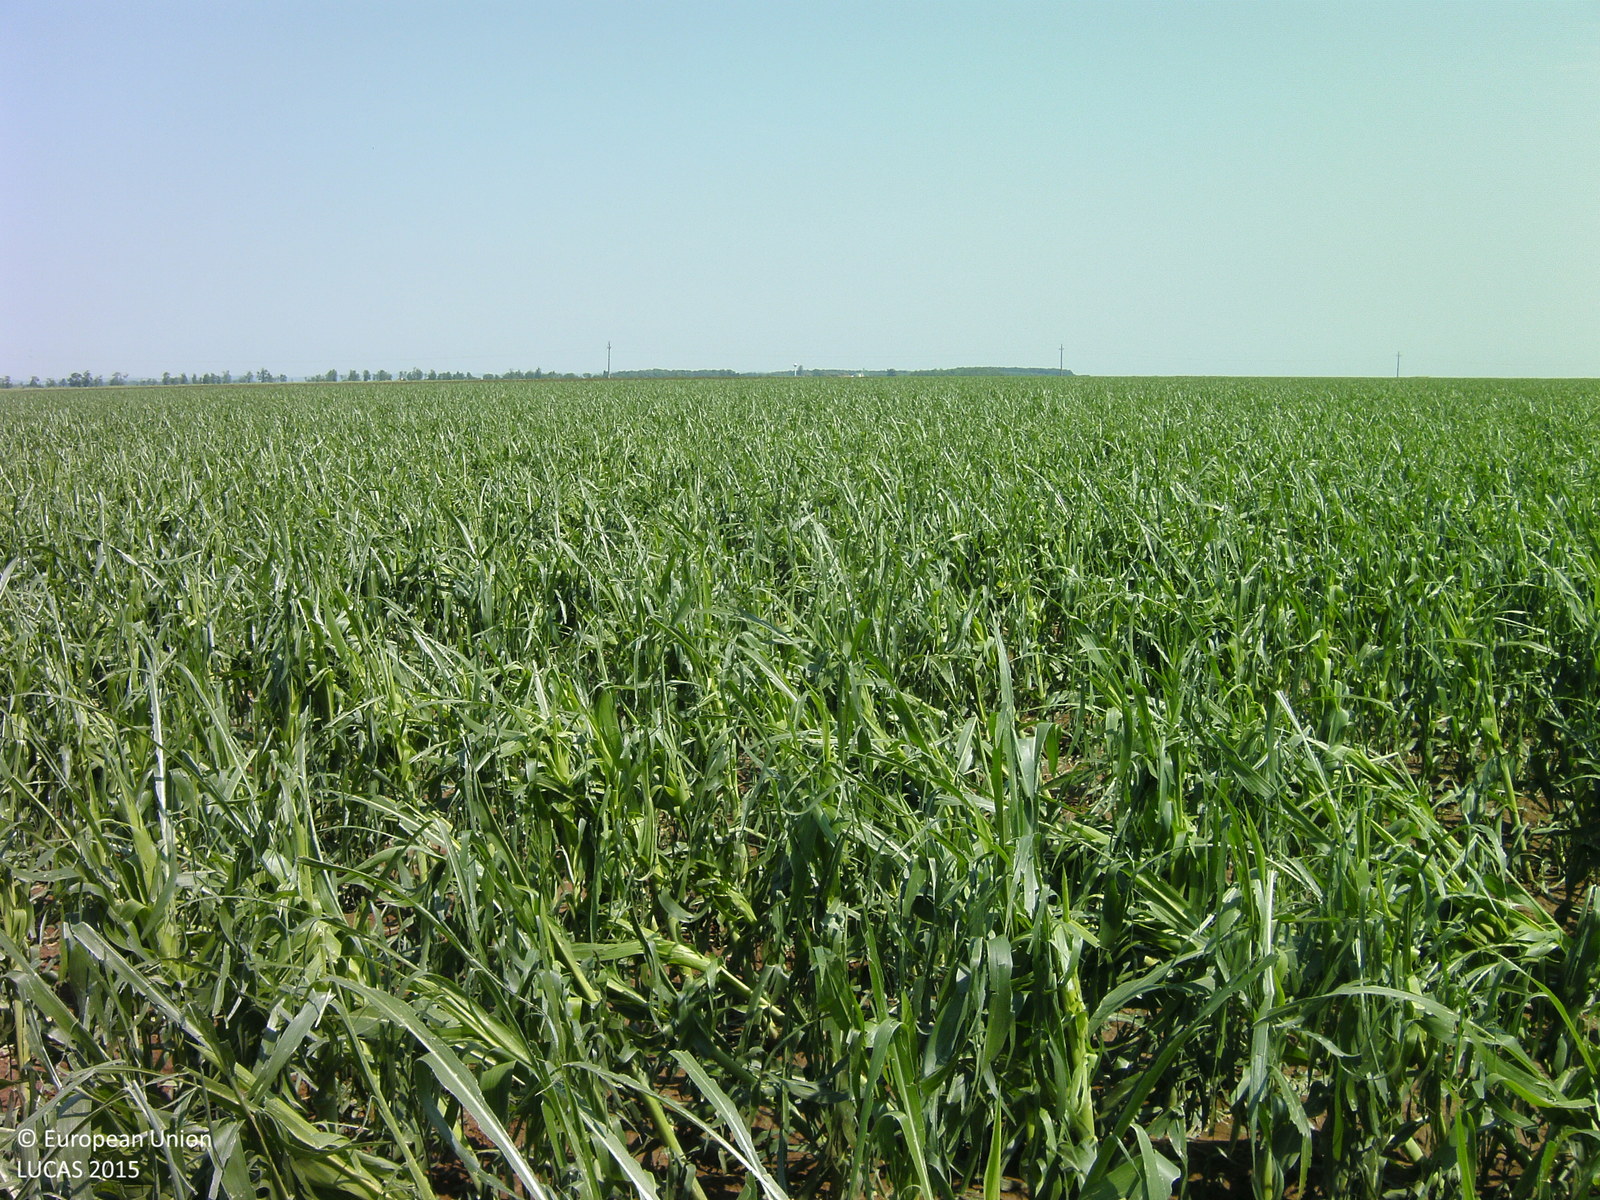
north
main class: Cropland
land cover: Maize
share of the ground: 50 - 75 %
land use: Agriculture (excluding fallow land and kitchen gardens)
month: June
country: HU
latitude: 46.3748
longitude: 18.0284
